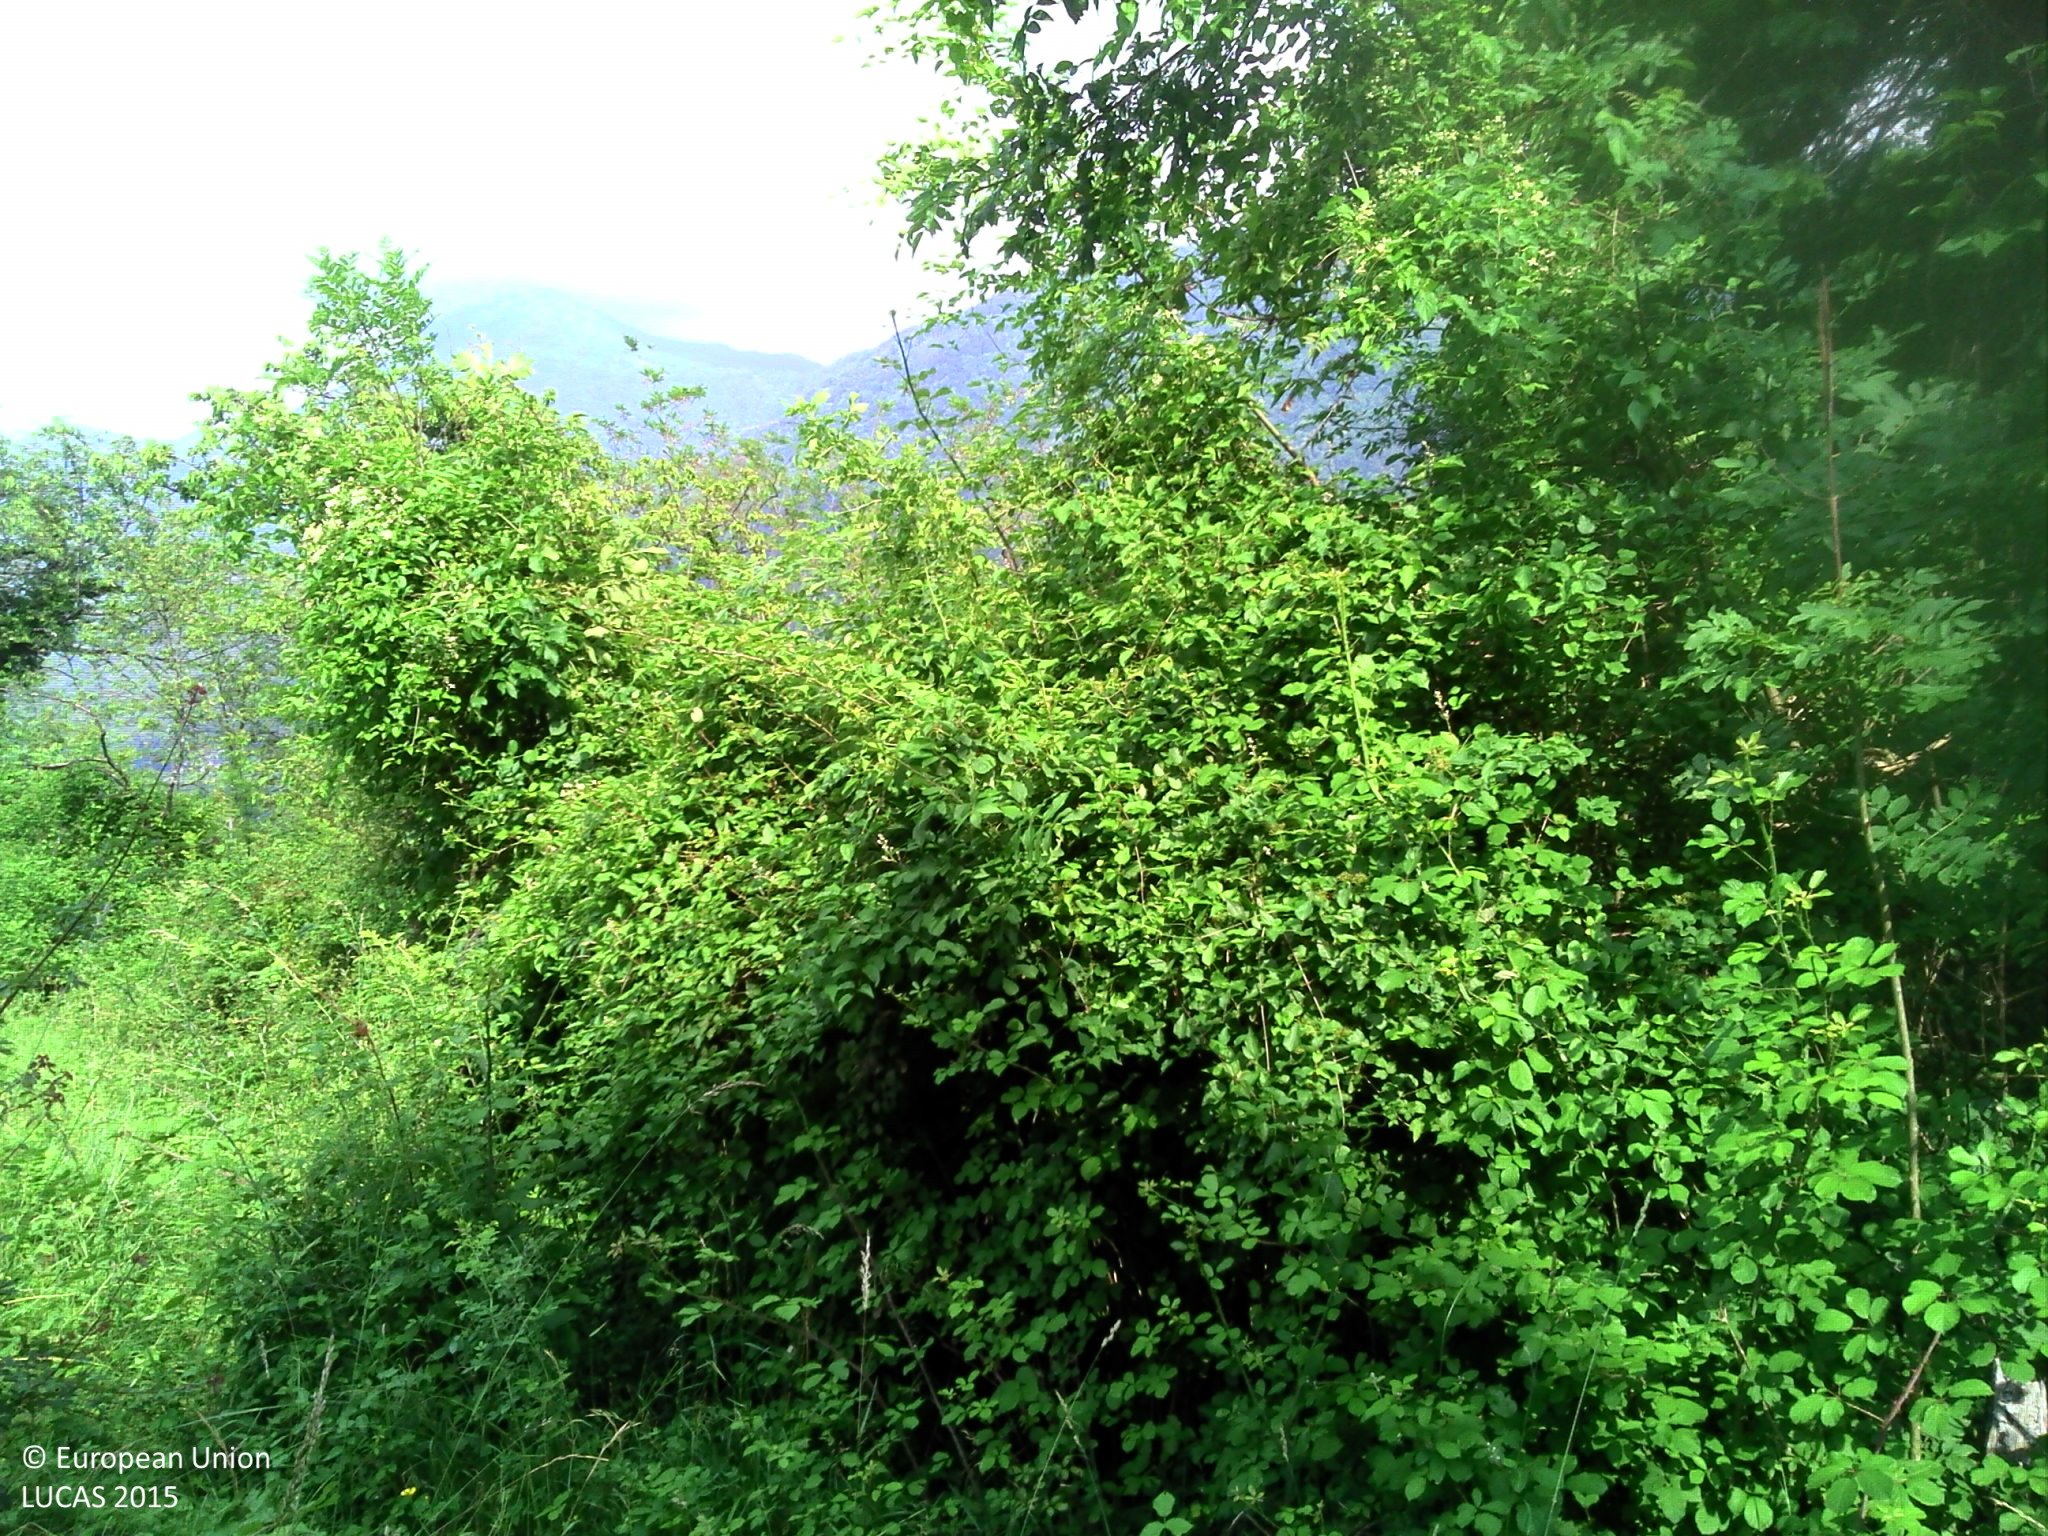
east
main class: Grassland
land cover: Spontaneously vegetated surfaces
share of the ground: > 75 %
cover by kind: herbaceous plants 95 %, shrubs 5 %
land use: Abandoned areas
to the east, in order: Spontaneously vegetated surfaces; Broadleaved woodland; Fences; Grassland with sparse tree/shrub cover; Fences; Broadleaved woodland; Dry stone walls; Vineyards; Grassland with sparse tree/shrub cover
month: June
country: FR
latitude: 45.5065
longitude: 6.1521
